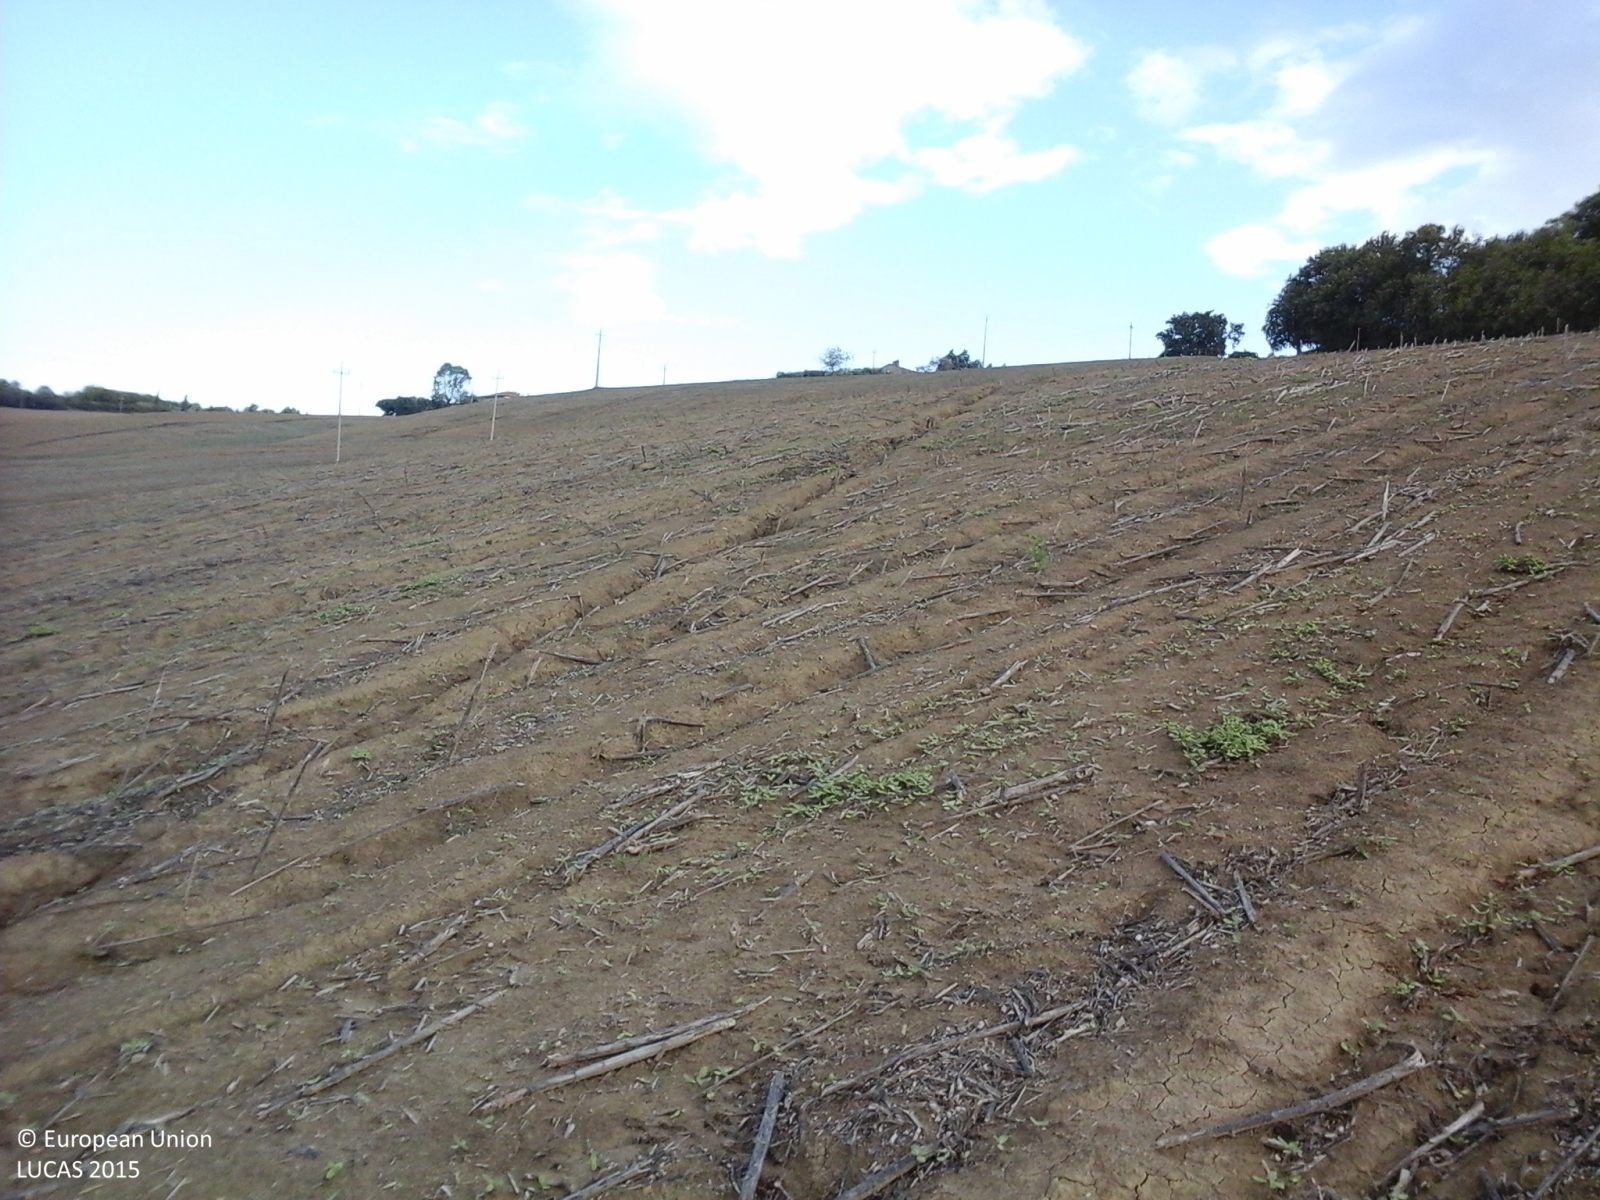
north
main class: Cropland
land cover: Sunflower
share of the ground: < 10 %
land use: Agriculture (excluding fallow land and kitchen gardens)
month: October
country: IT
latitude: 43.6332
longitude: 13.2025
